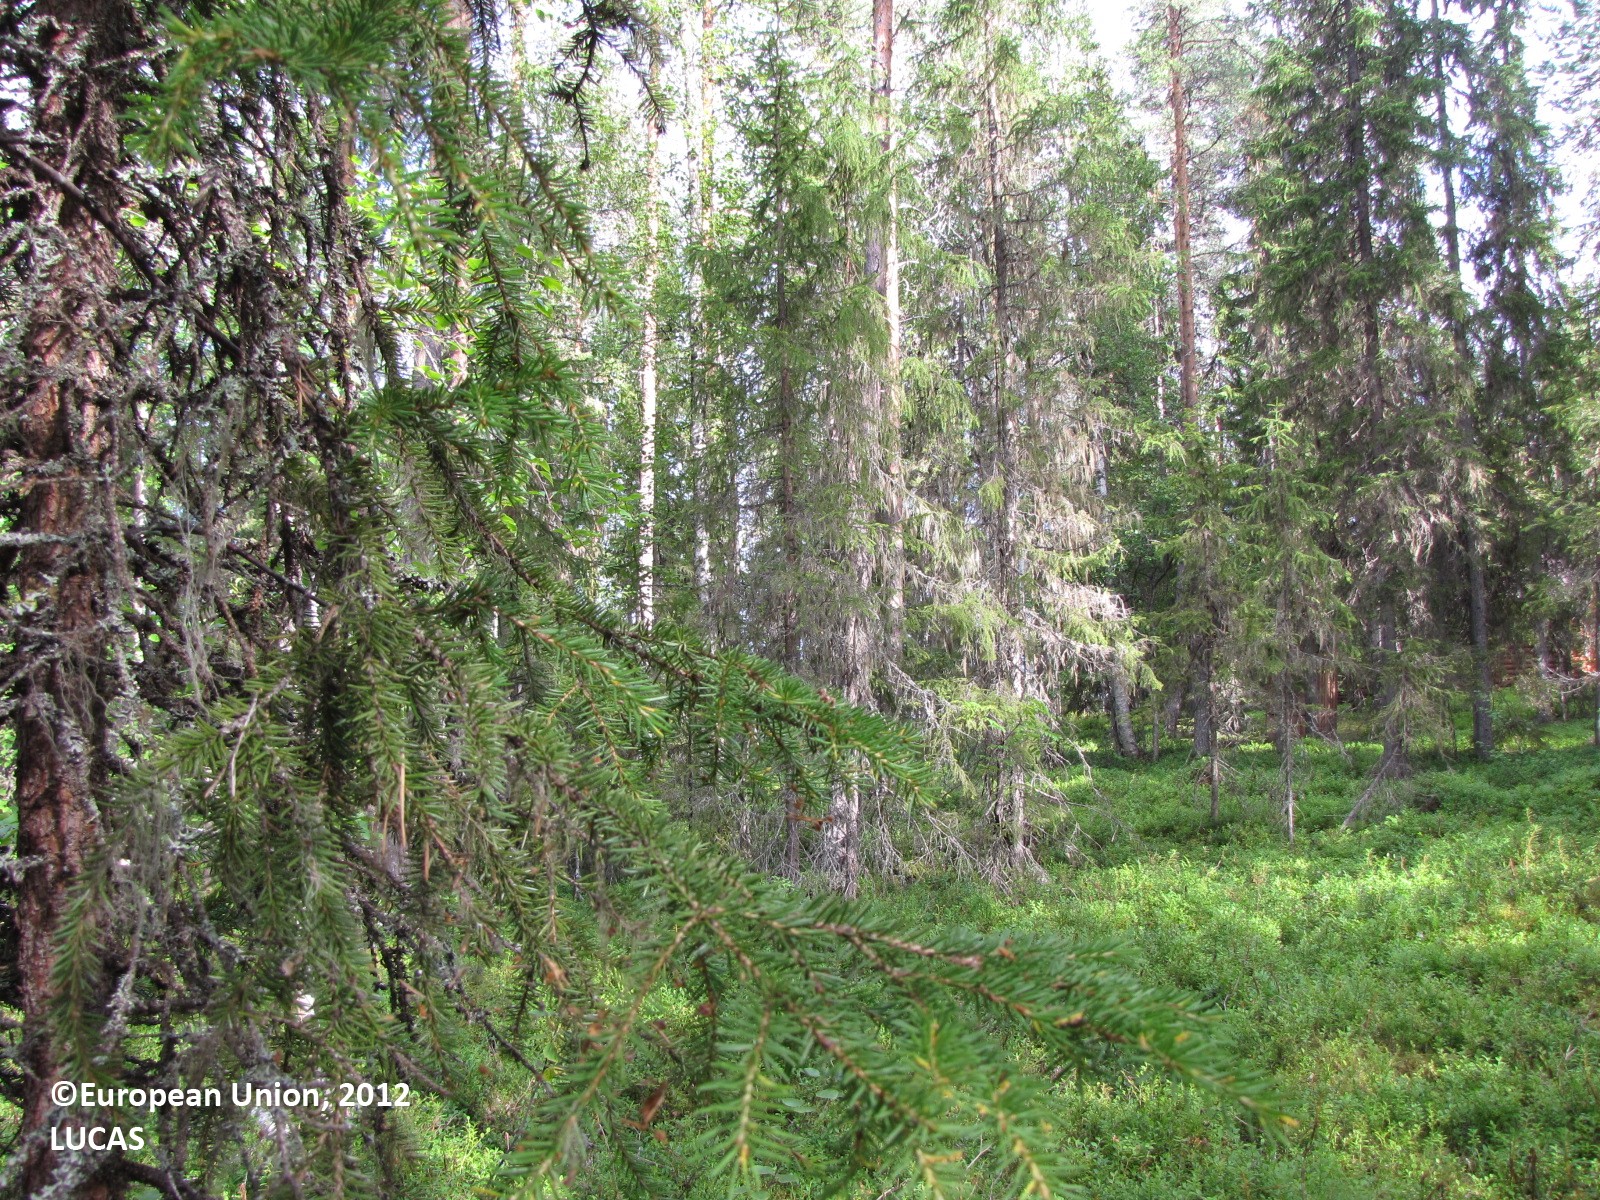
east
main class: Woodland
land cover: Other coniferous woodland
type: boreal forest
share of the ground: 25 - 50 %
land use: Forestry
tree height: > 5 m
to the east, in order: Other coniferous woodland; Pine dominated mixed woodland; Shrubland with sparse tree cover; Inland water bodies
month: August
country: FI
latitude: 66.8626
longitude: 25.1724
